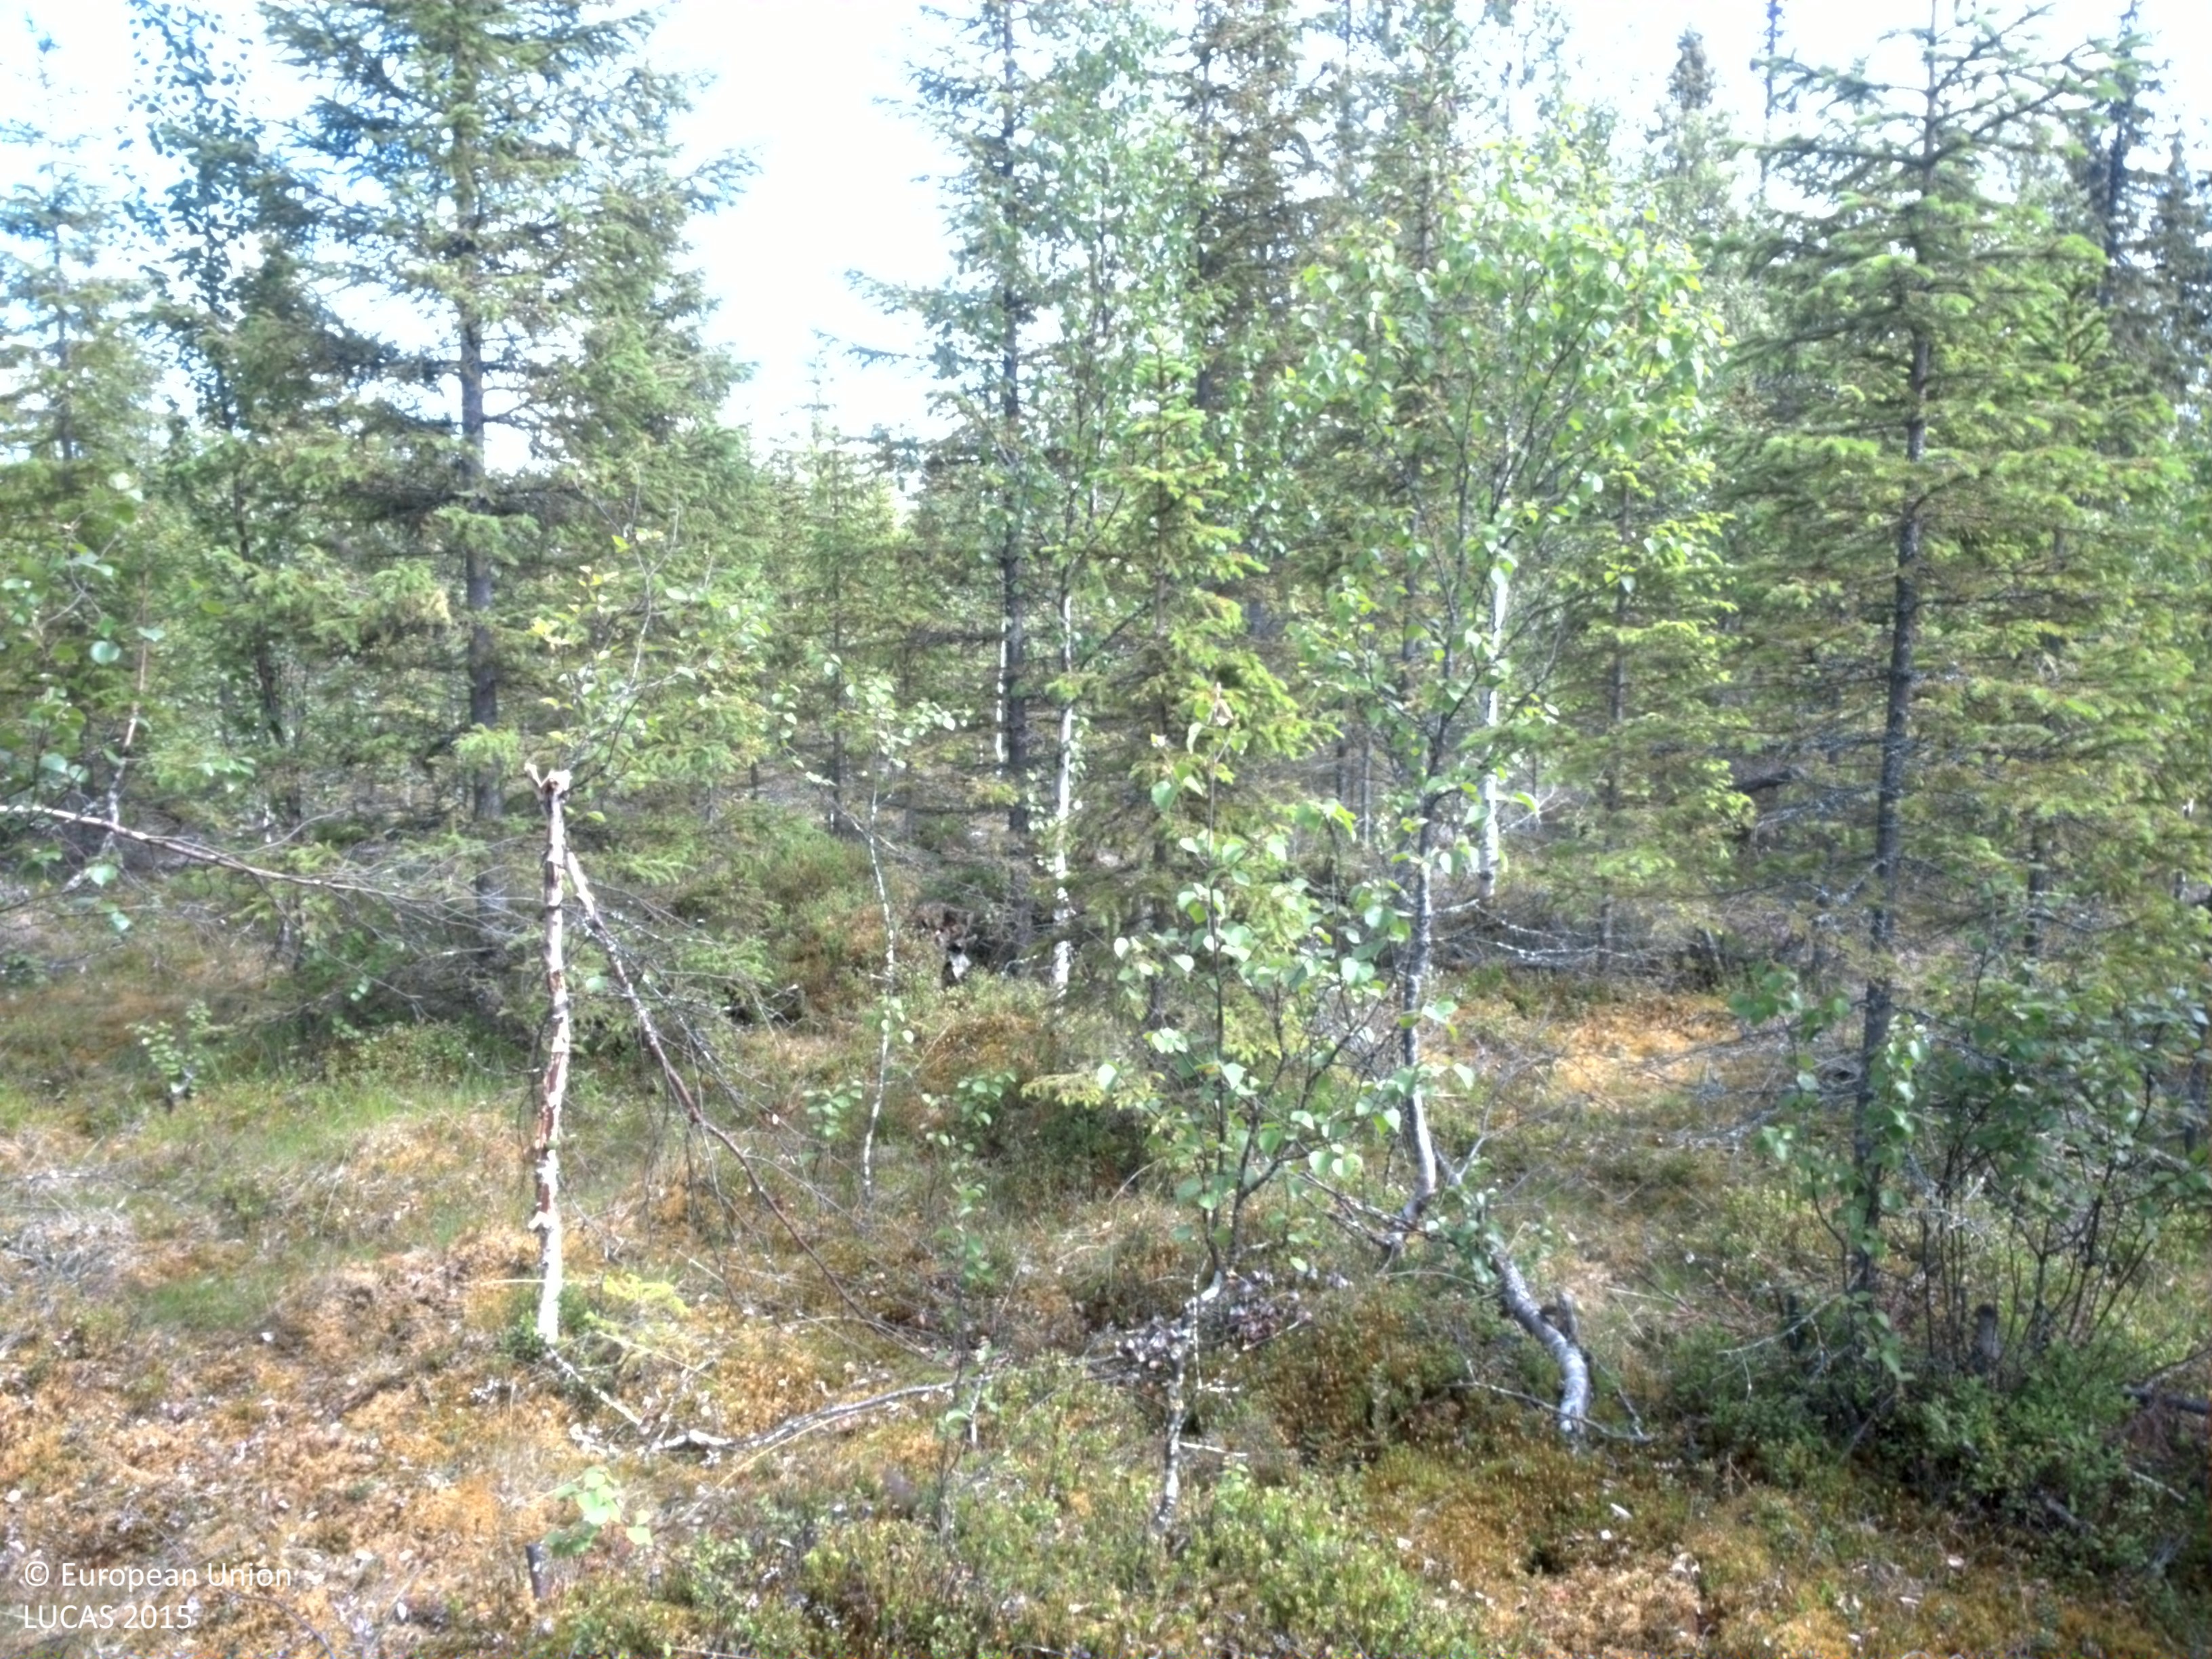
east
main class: Woodland
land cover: Spruce dominated mixed woodland
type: boreal forest
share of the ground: 25 - 50 %
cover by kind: coniferous forest trees 30 %, shrubs 25 %, lichens and mosses 25 %, broadleaved forest trees 10 %, herbaceous plants 10 %
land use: Forestry
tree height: < 5 m
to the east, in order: Spruce dominated mixed woodland; Ditches and canals; Spruce dominated mixed woodland; Ditches and canals; Spruce dominated mixed woodland; Pine dominated mixed woodland; Spruce dominated mixed woodland; Tracks; Spruce dominated mixed woodland
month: July
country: SE
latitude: 64.4912
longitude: 18.2719
